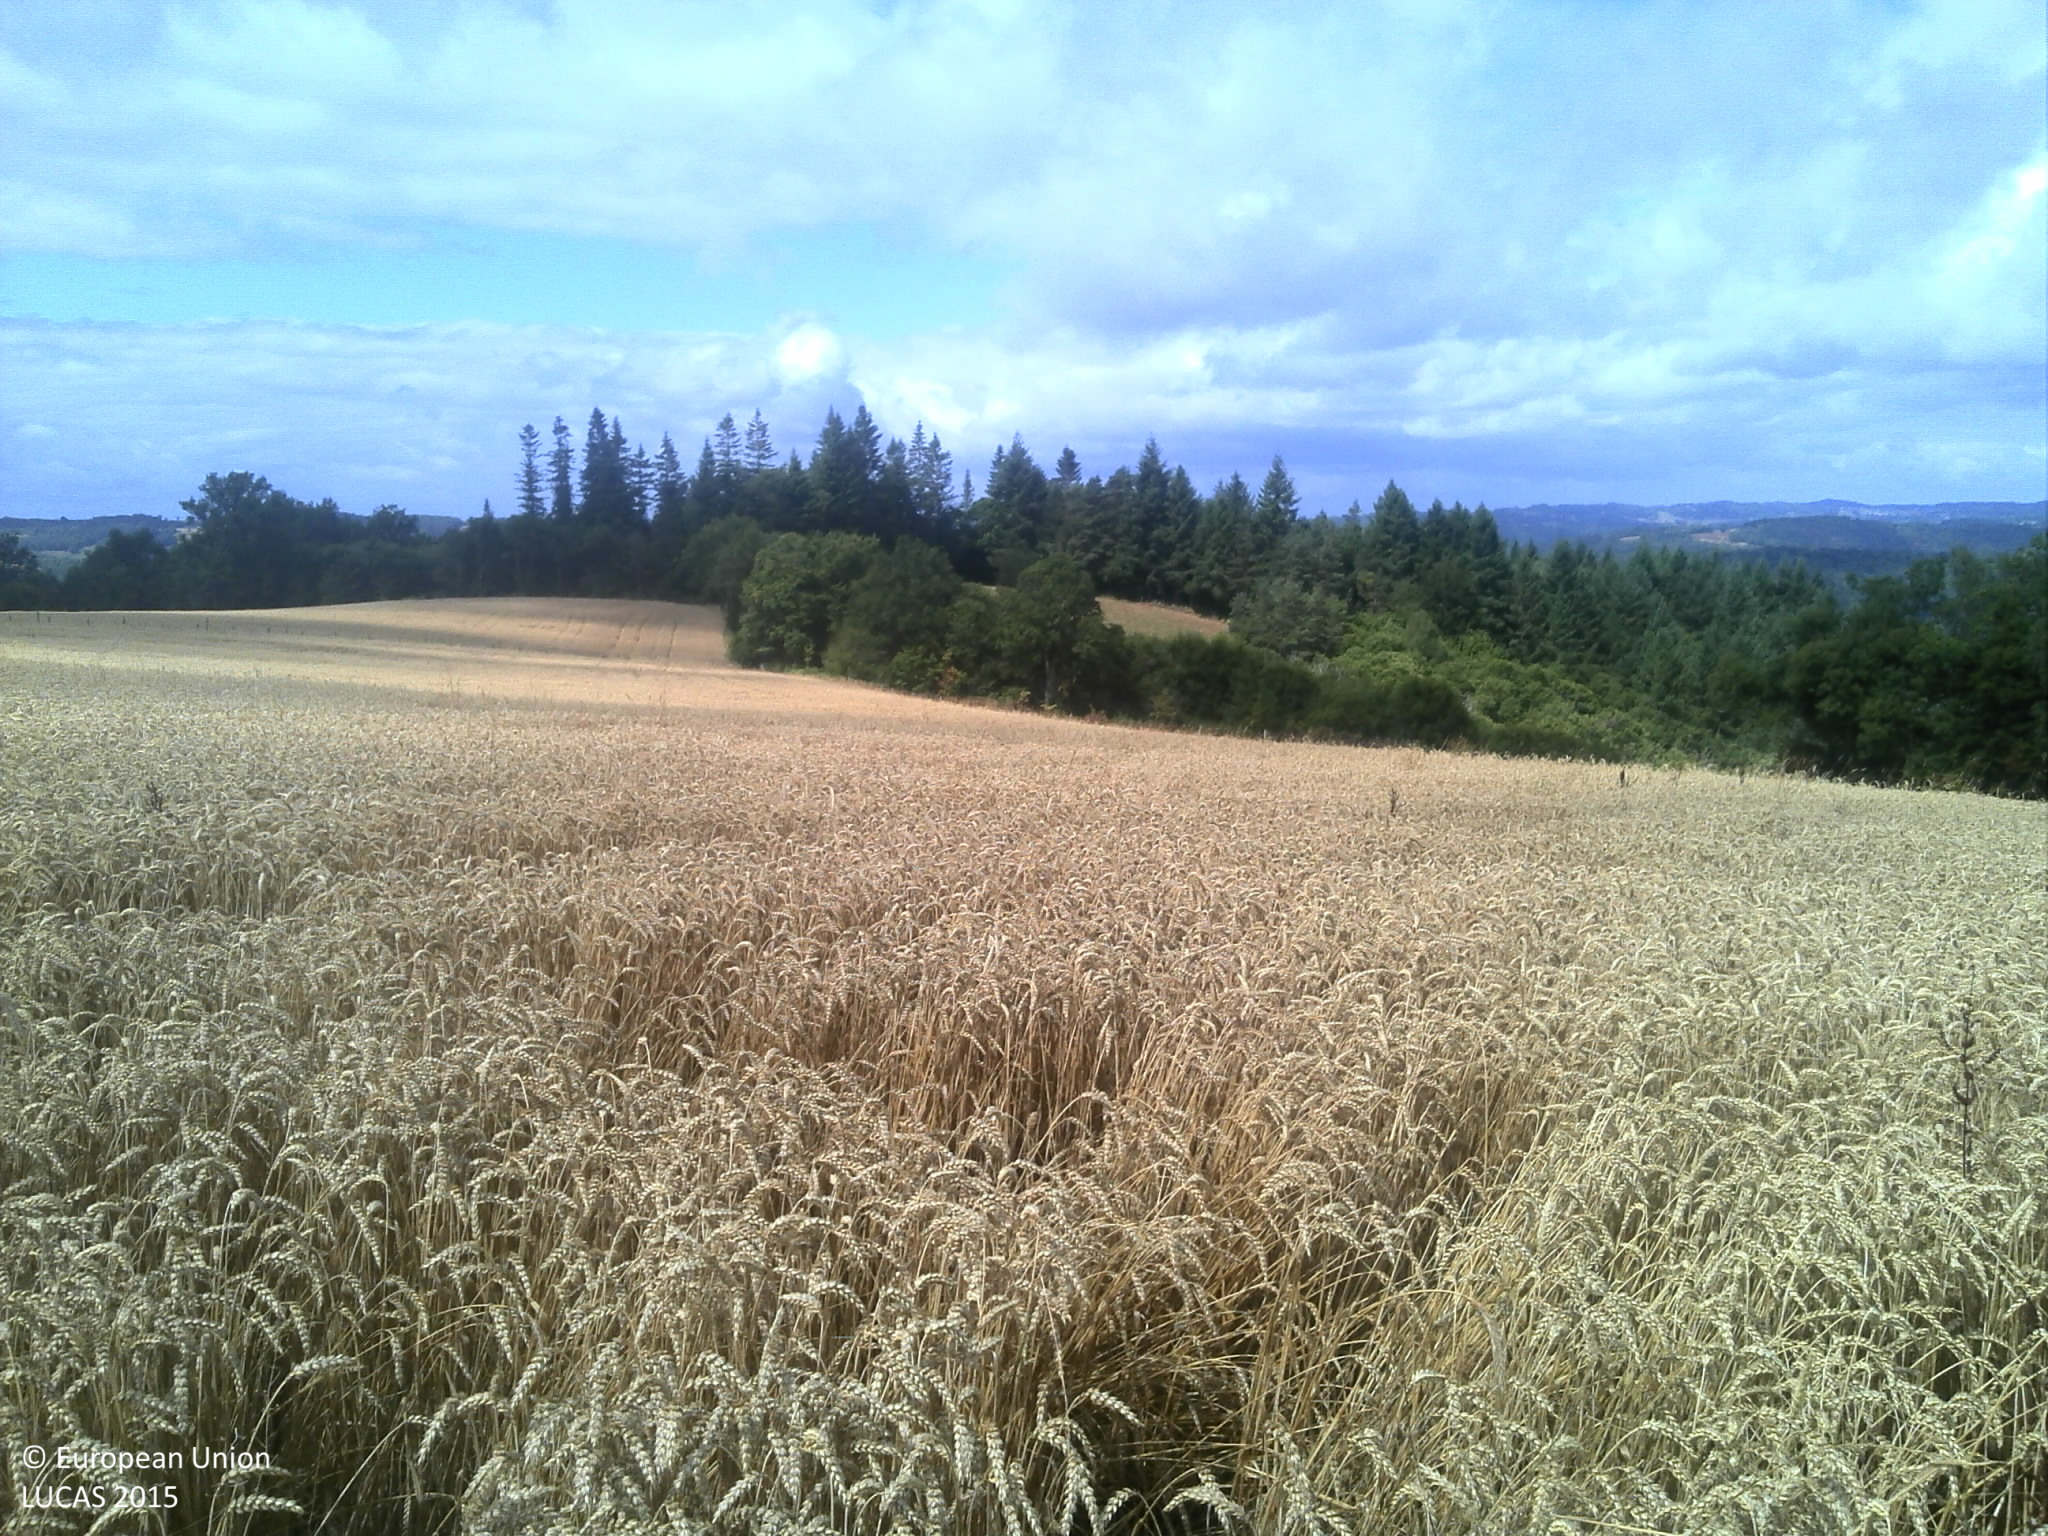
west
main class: Cropland
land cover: Common wheat
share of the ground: > 75 %
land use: Agriculture (excluding fallow land and kitchen gardens)
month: July
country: FR
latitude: 45.0507
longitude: 1.9352
